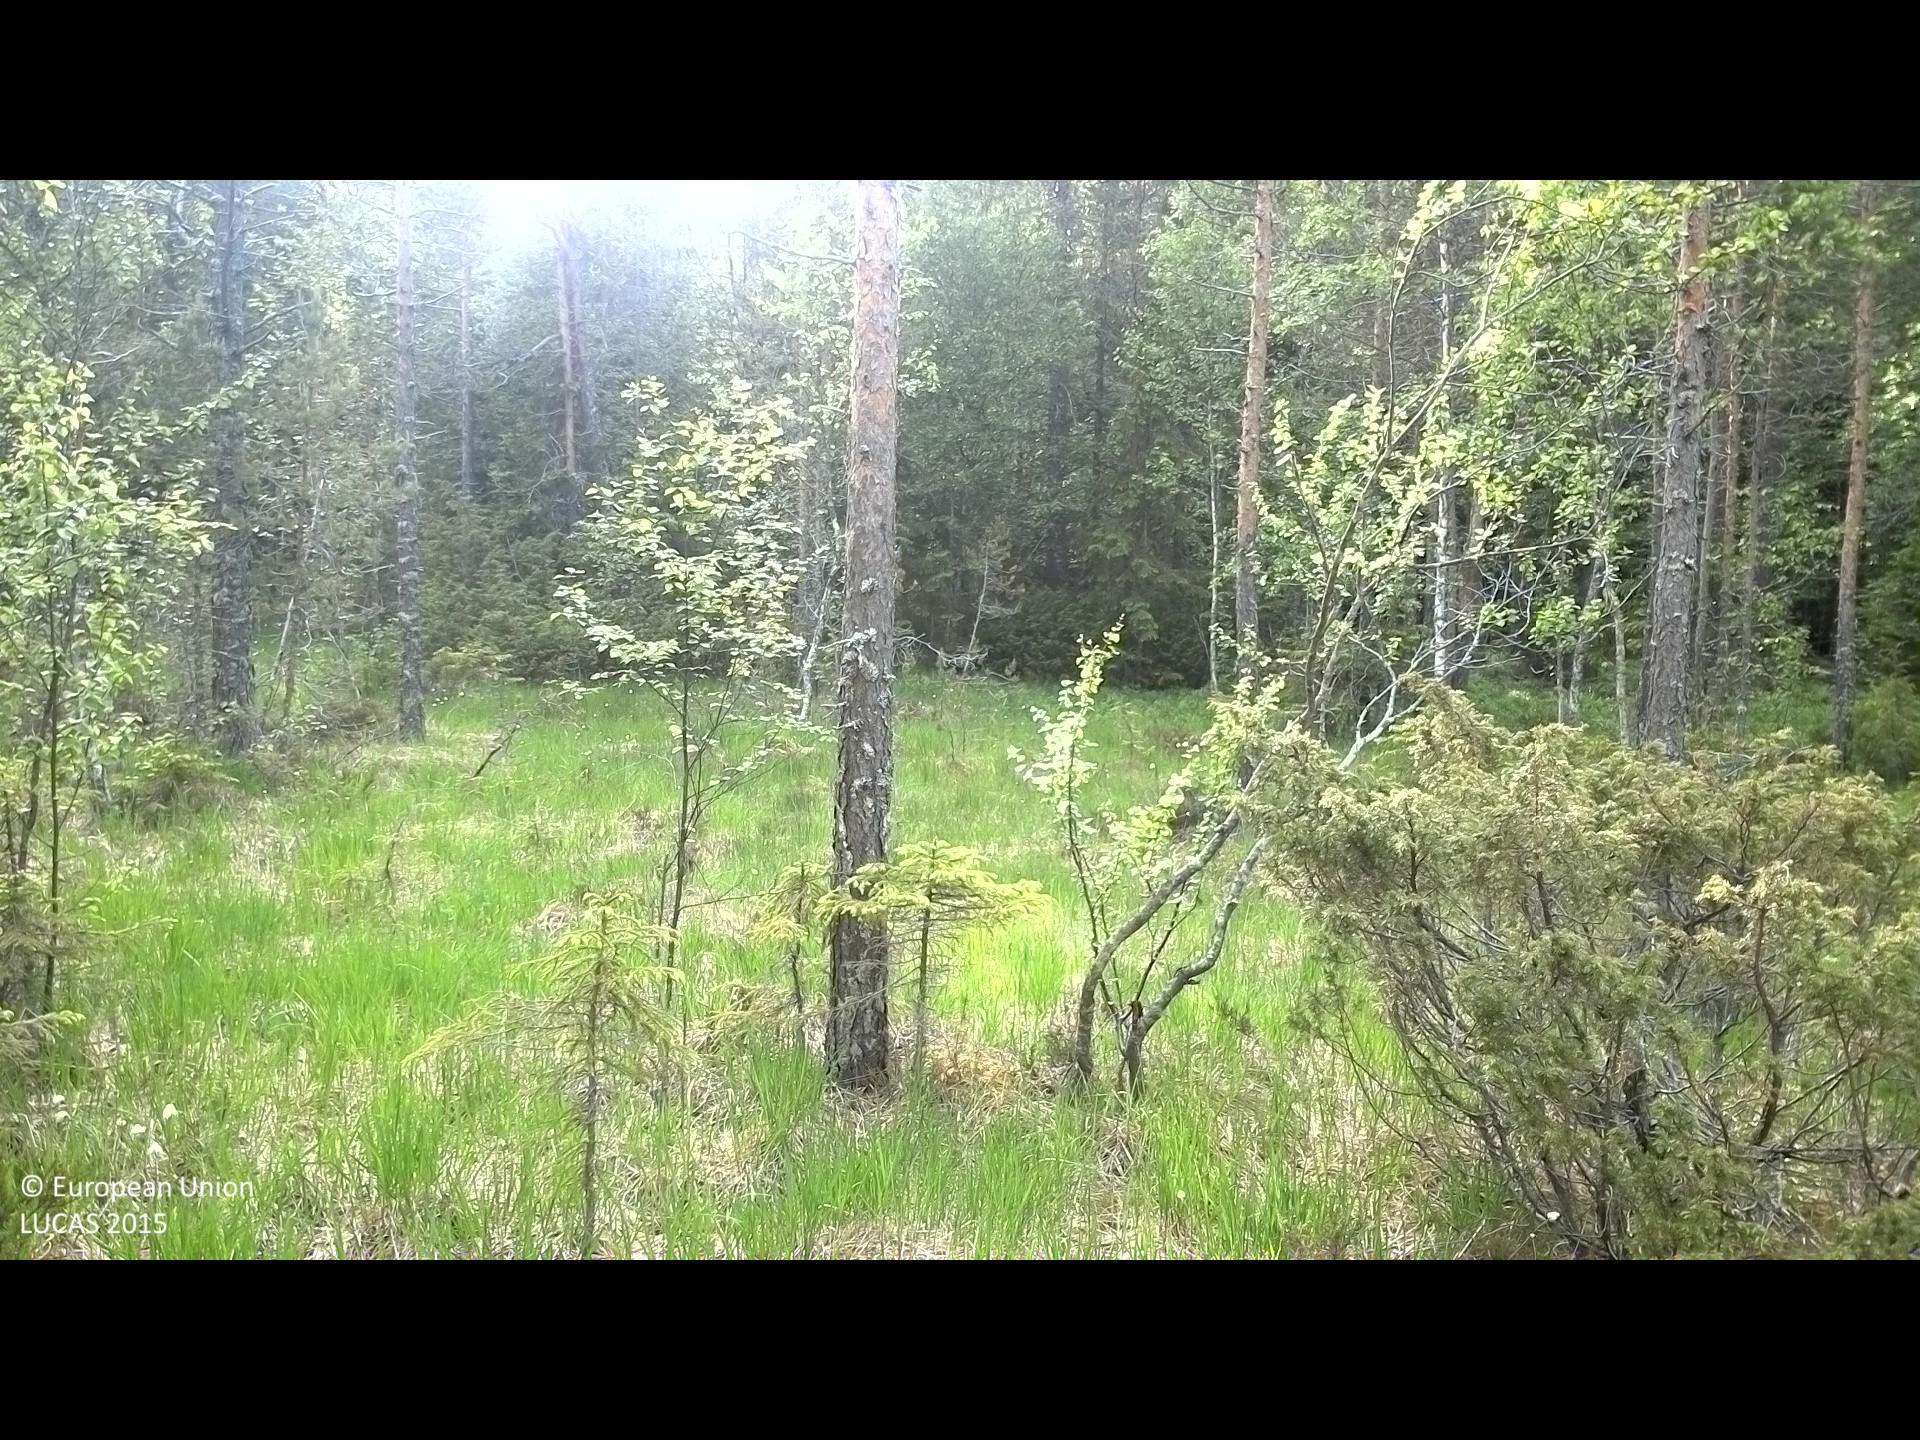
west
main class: Woodland
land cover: Pine dominated mixed woodland
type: boreal forest
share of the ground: 10 - 25 %
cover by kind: herbaceous plants 40 %, lichens and mosses 30 %, coniferous forest trees 15 %, broadleaved forest trees 10 %, shrubs 5 %
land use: Semi-natural and natural areas not in use
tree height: > 5 m
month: June
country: SE
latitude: 62.0079
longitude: 16.7619
